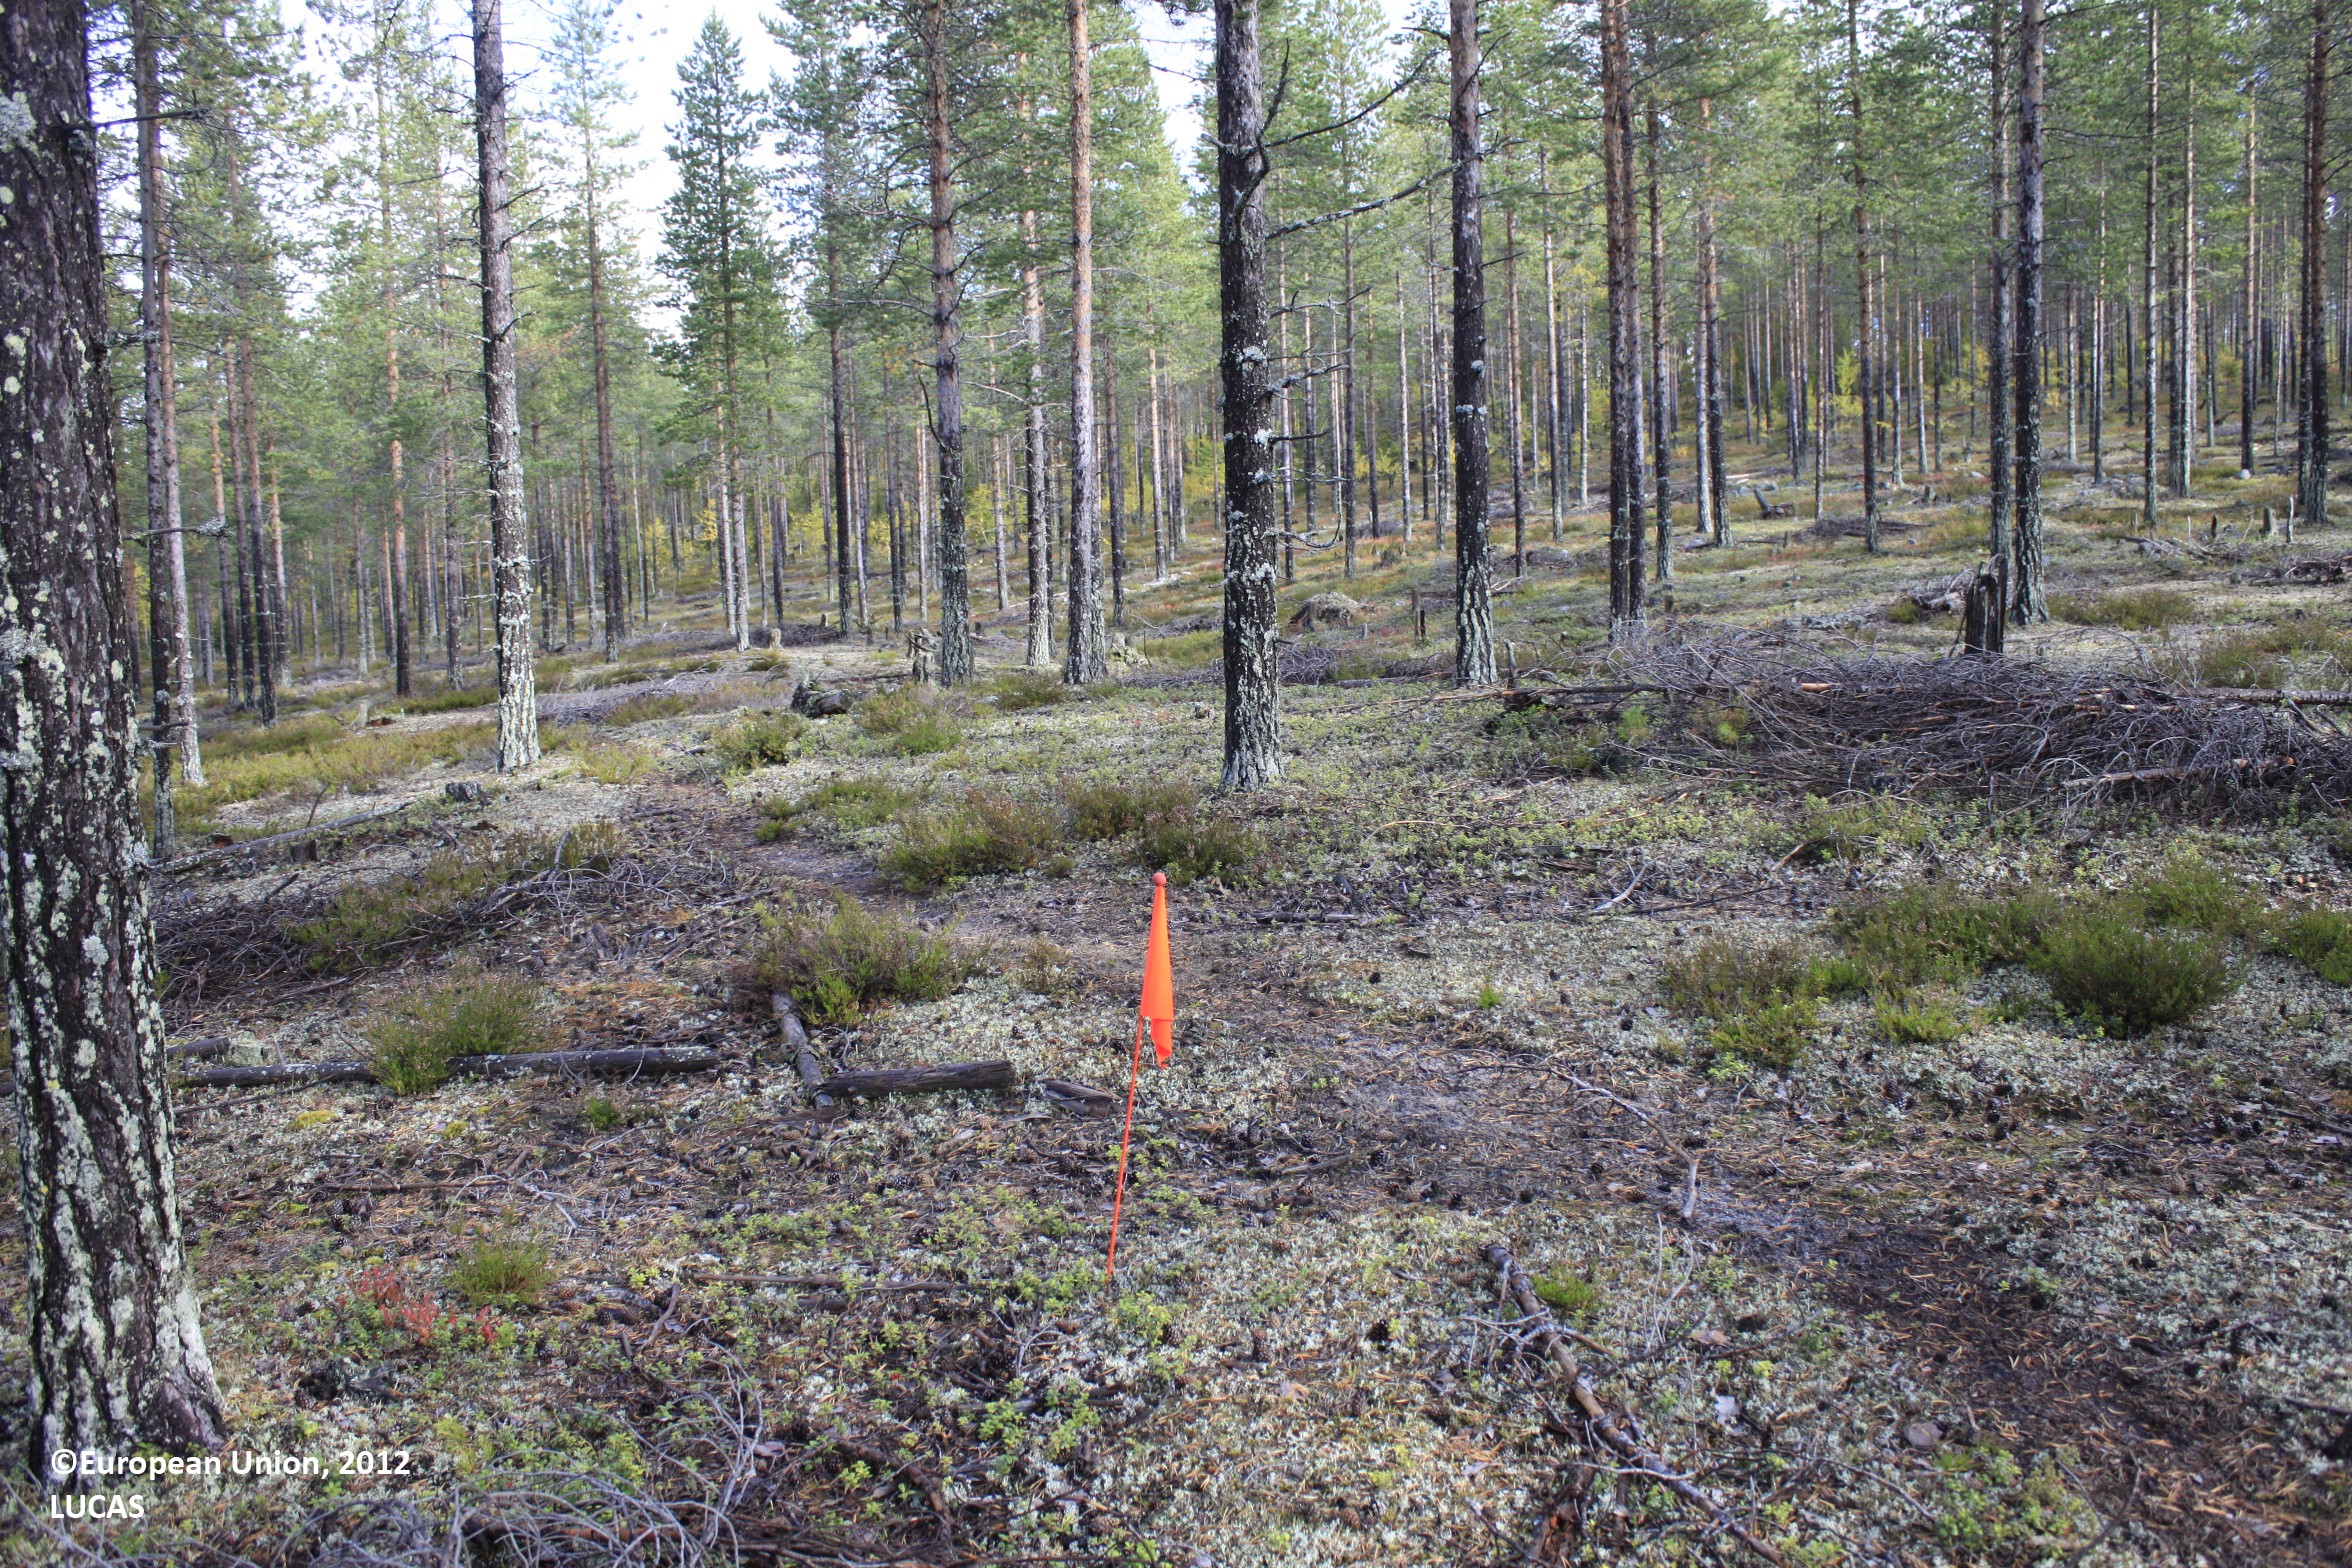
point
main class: Woodland
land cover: Pine dominated coniferous woodland
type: boreal forest
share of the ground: 25 - 50 %
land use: Forestry
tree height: > 5 m
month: September
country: FI
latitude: 65.5710
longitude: 27.3516
